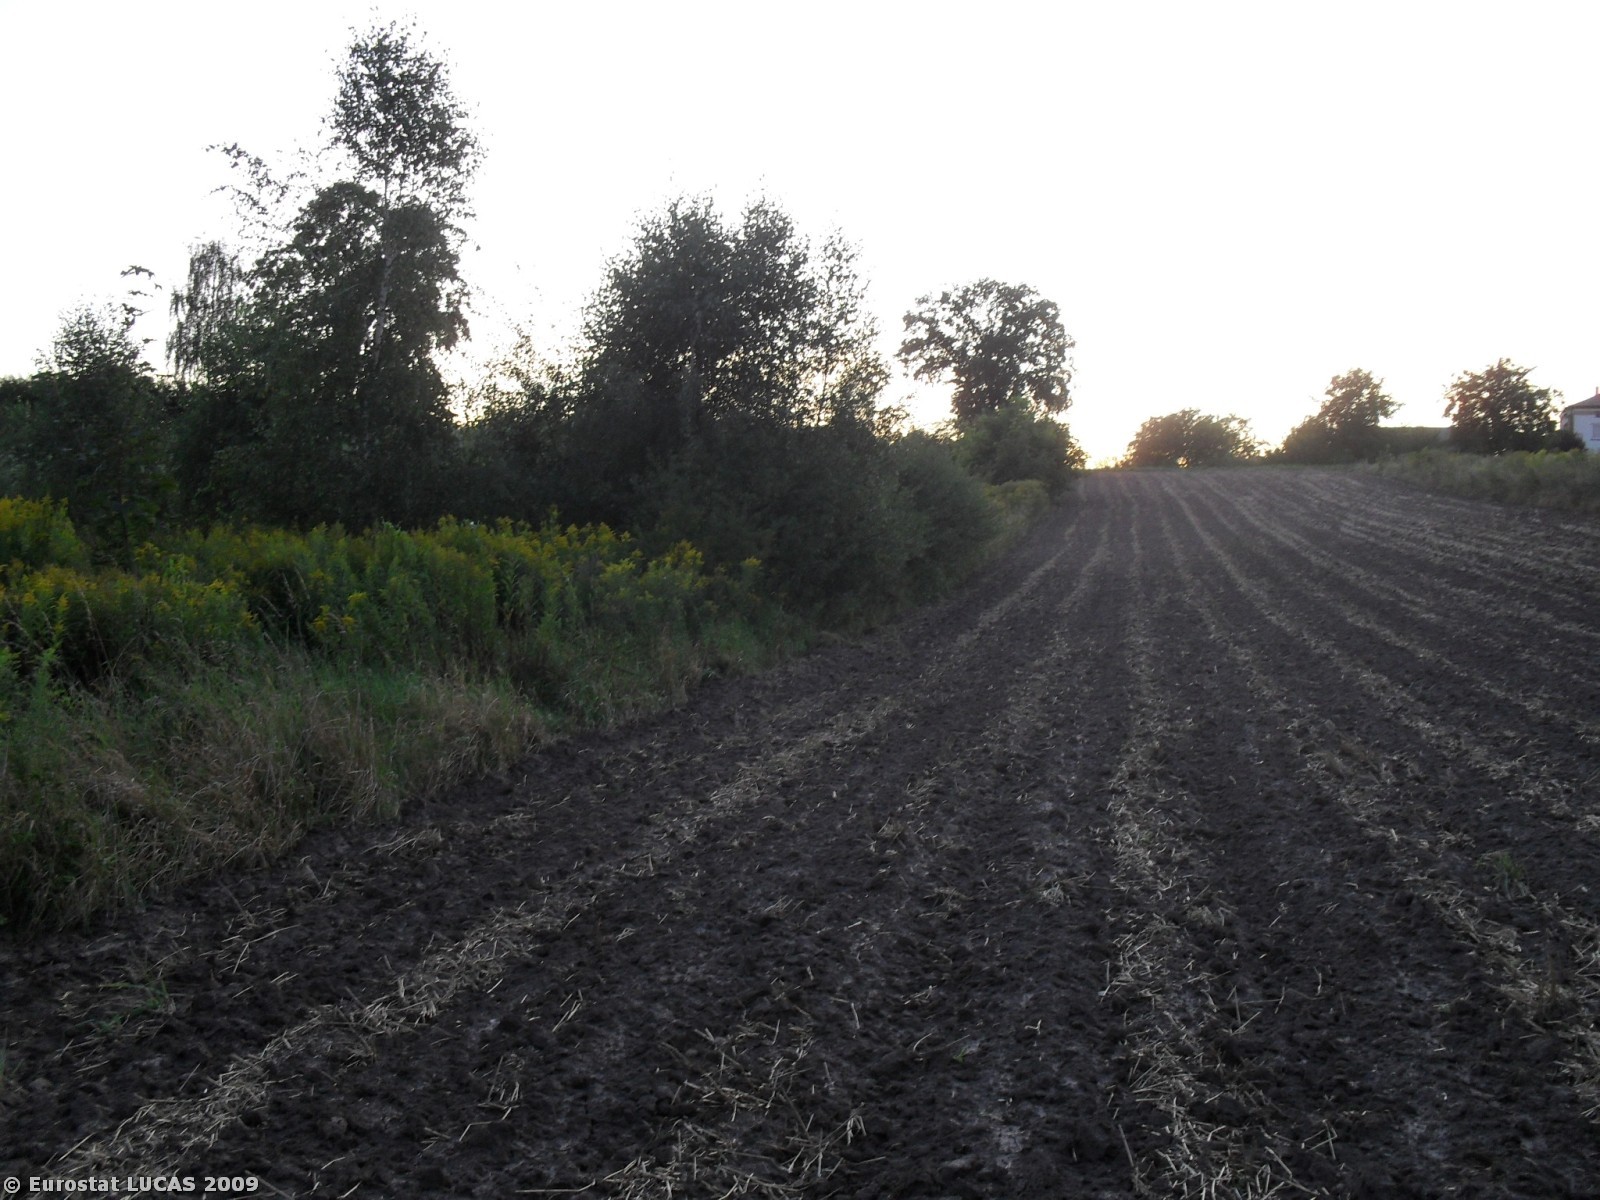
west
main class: Cropland
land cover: Common wheat
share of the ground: < 10 %
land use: Agriculture (excluding fallow land and kitchen gardens)
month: August
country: PL
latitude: 51.3106
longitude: 22.0088
